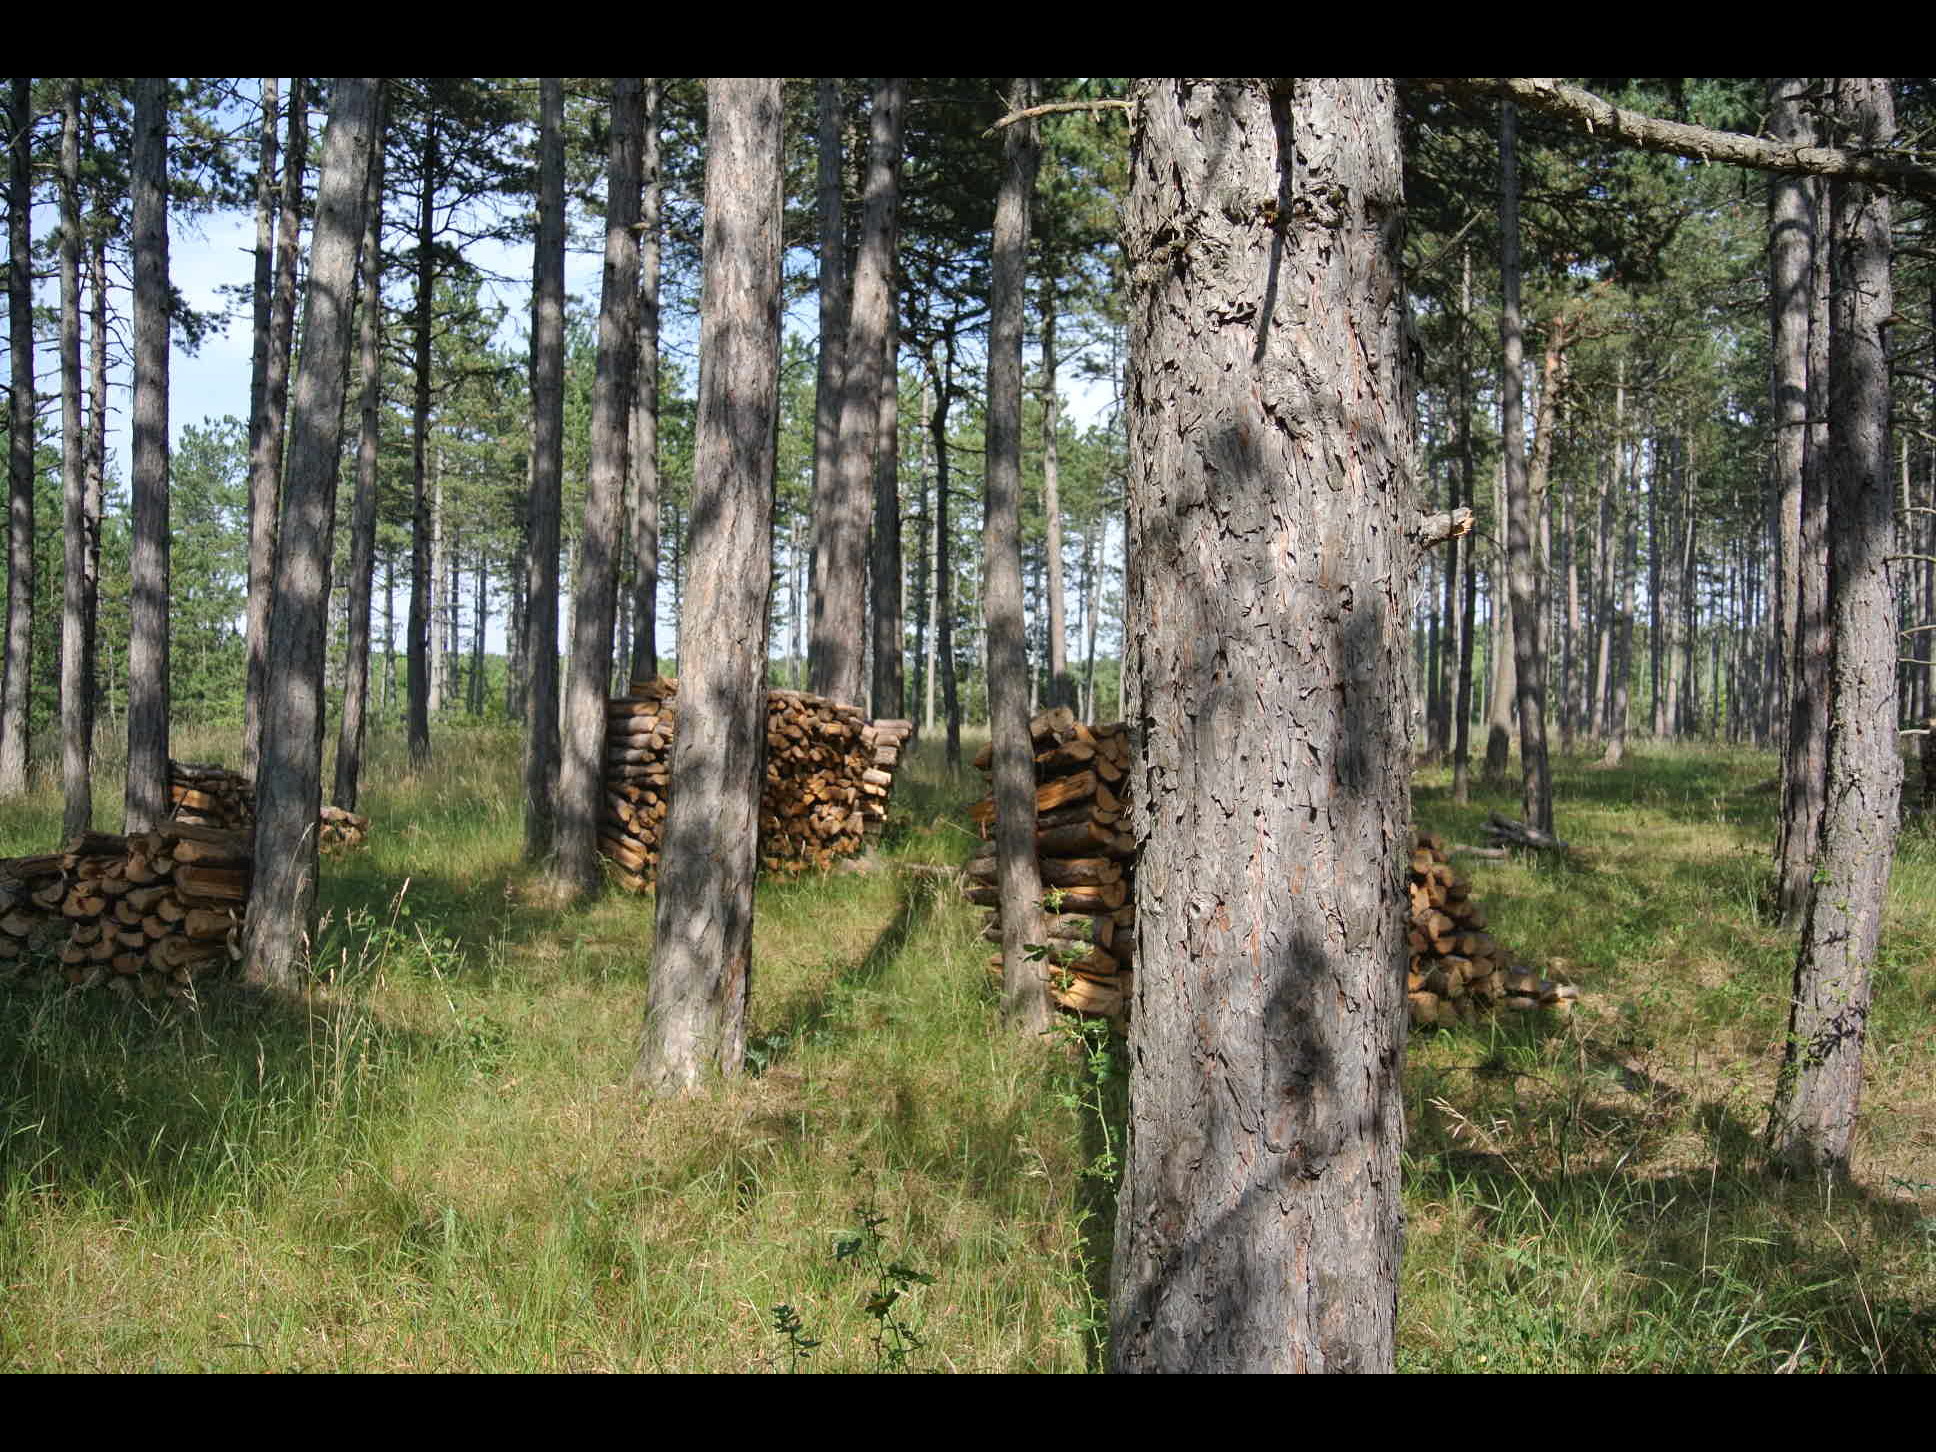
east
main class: Woodland
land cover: Pine dominated coniferous woodland
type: alpine coniferous forest
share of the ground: 25 - 50 %
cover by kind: coniferous forest trees 90 %, herbaceous plants 10 %
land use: Forestry
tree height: > 5 m
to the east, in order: Pine dominated coniferous woodland; Pine dominated mixed woodland; Fences; Pine dominated mixed woodland
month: July
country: AT
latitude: 47.7629
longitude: 16.1538
